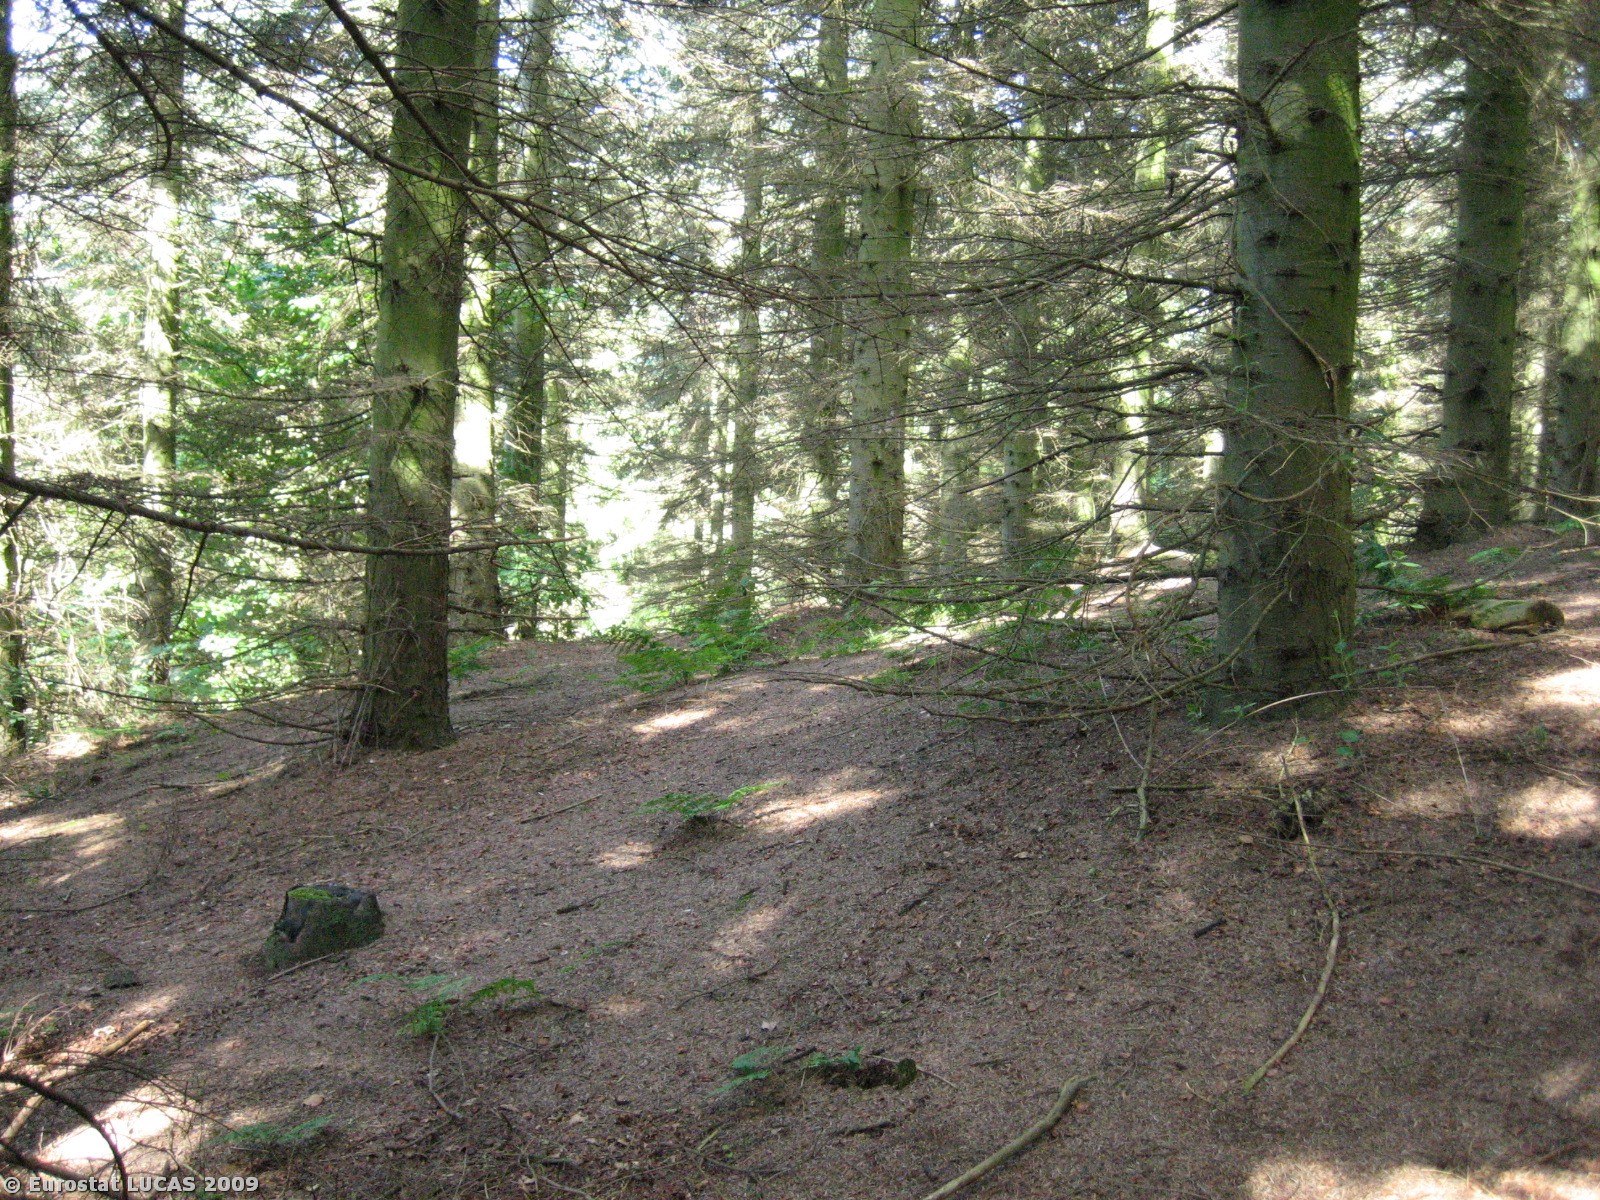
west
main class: Woodland
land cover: Coniferous woodland
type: hemiboreal forest and nemoral coniferous forest and mixed broadleaved-coniferous forest
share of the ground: > 75 %
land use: Forestry
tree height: > 5 m
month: June
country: DK
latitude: 55.7922
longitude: 9.8566
